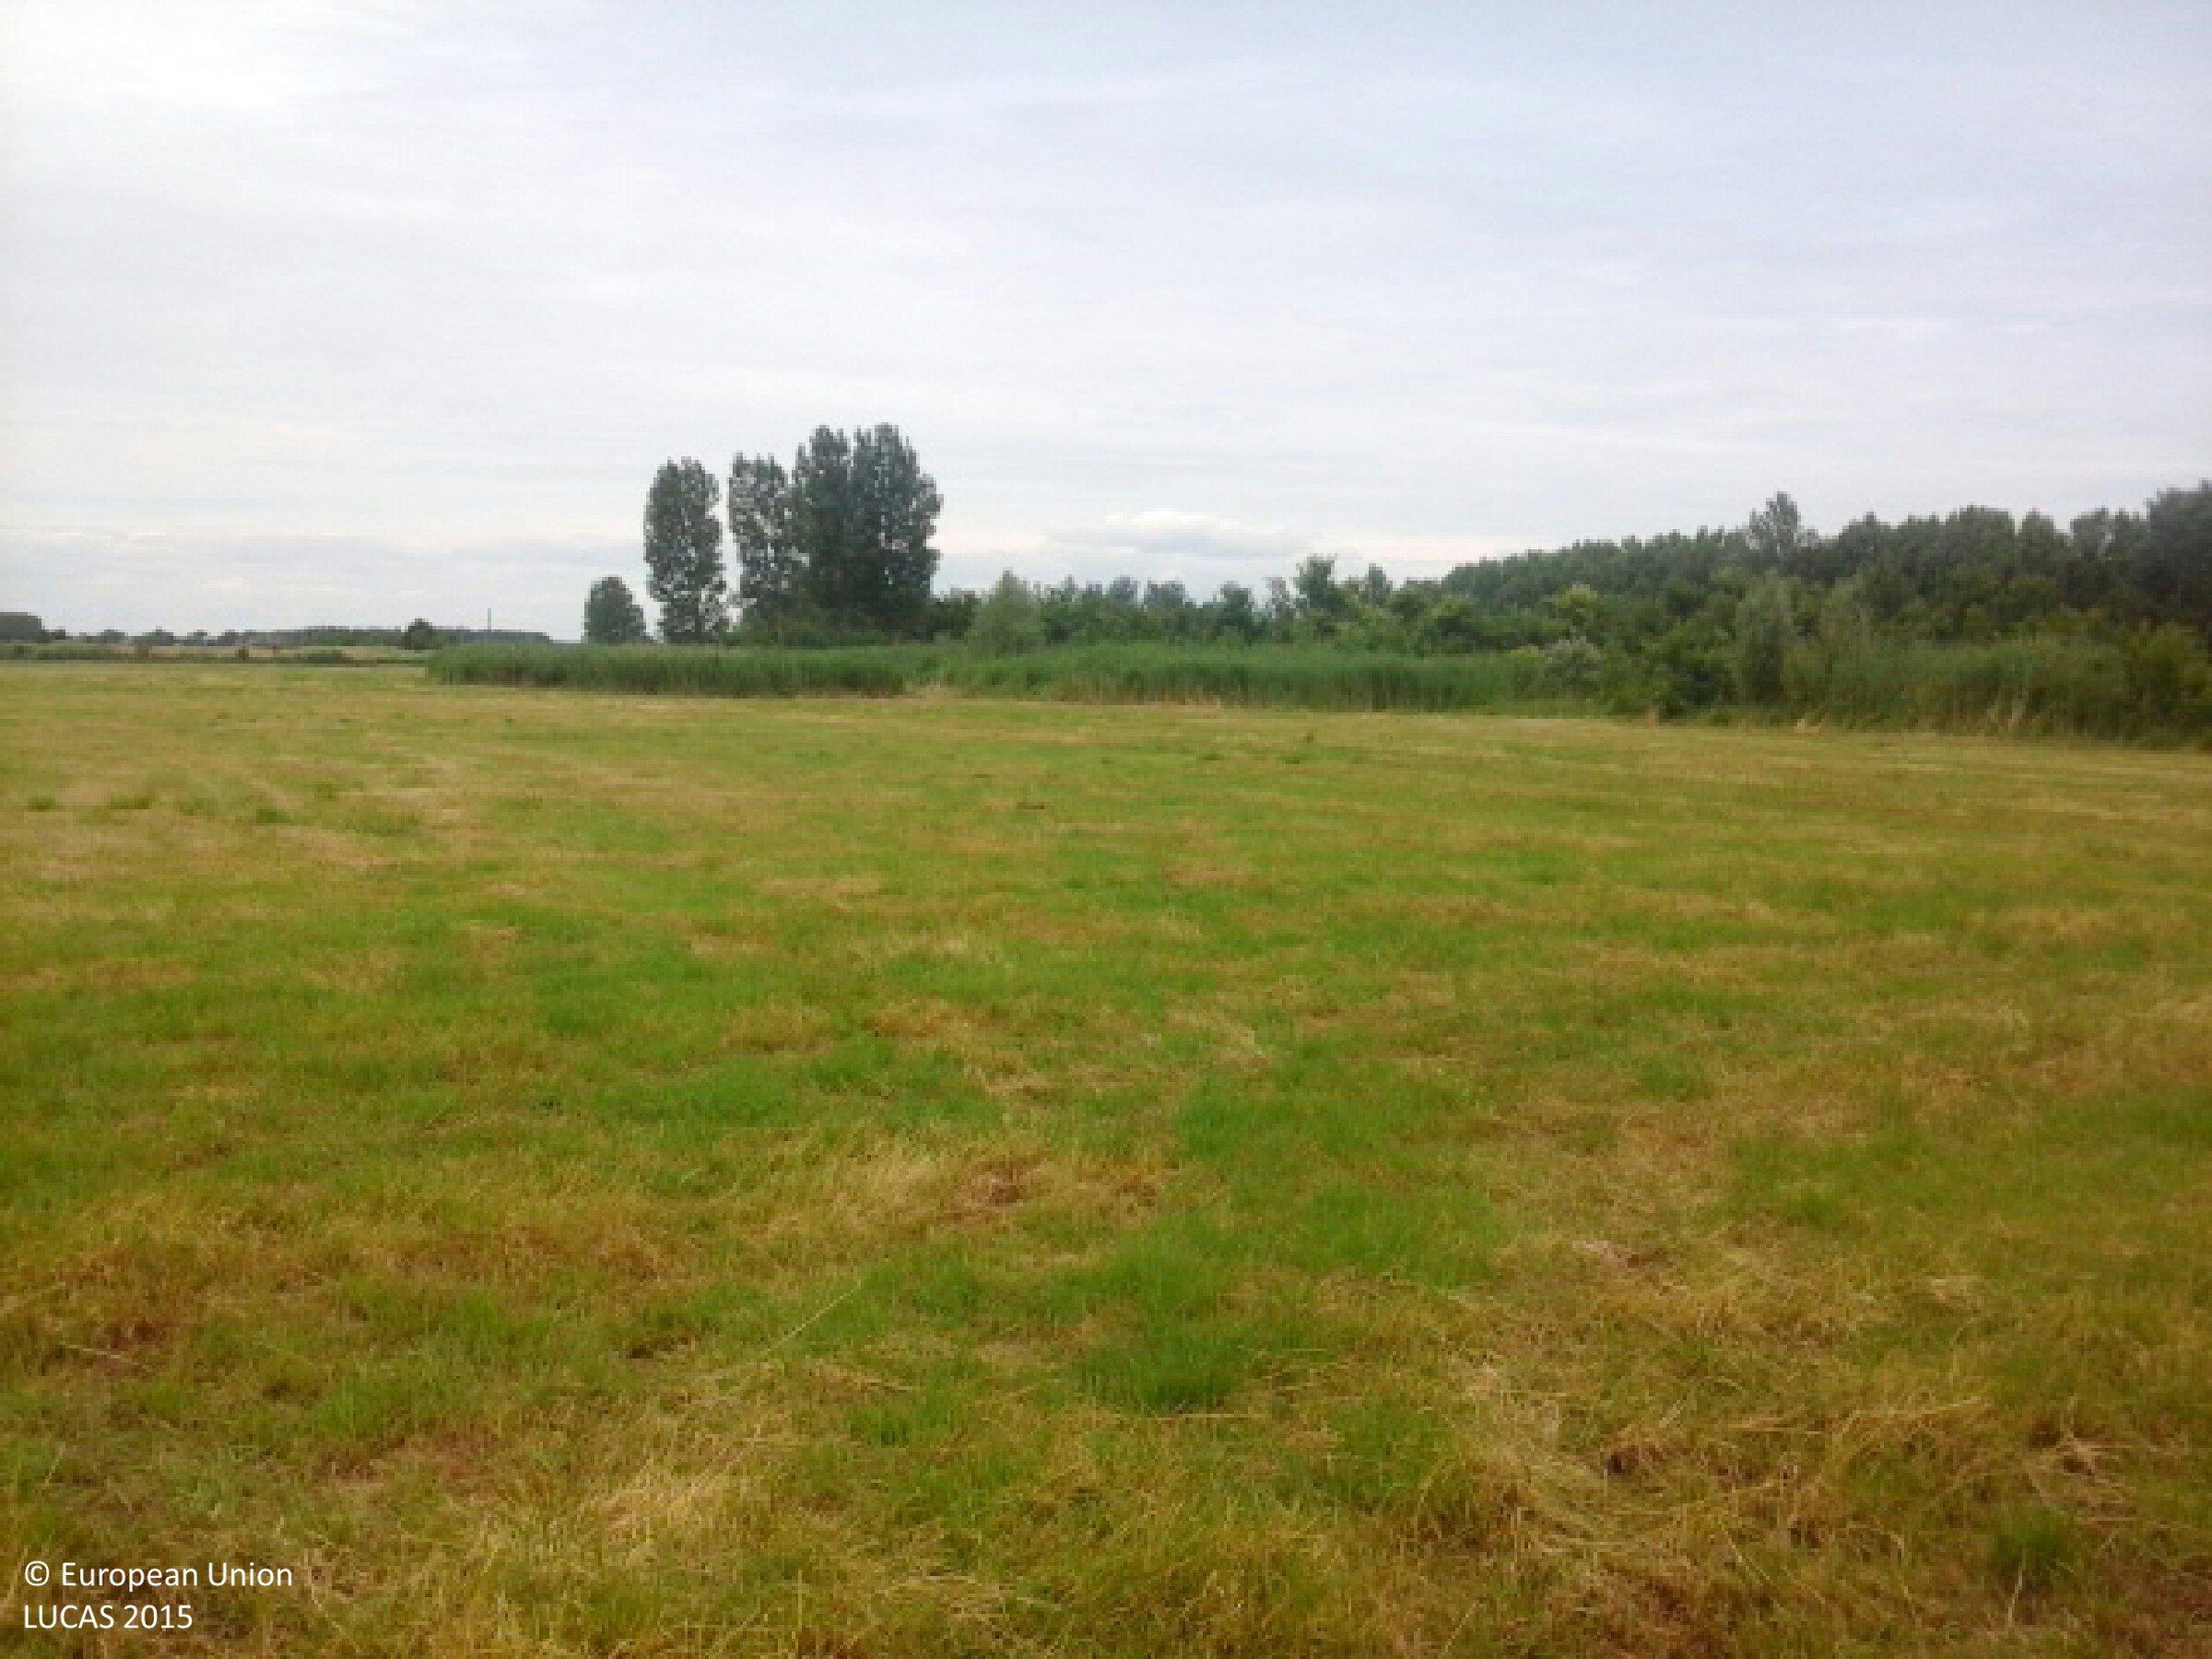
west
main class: Grassland
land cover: Grassland without tree/shrub cover
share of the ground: > 75 %
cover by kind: herbaceous plants 100 %
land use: Abandoned areas
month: June
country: HU
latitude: 48.1349
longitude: 21.7805
